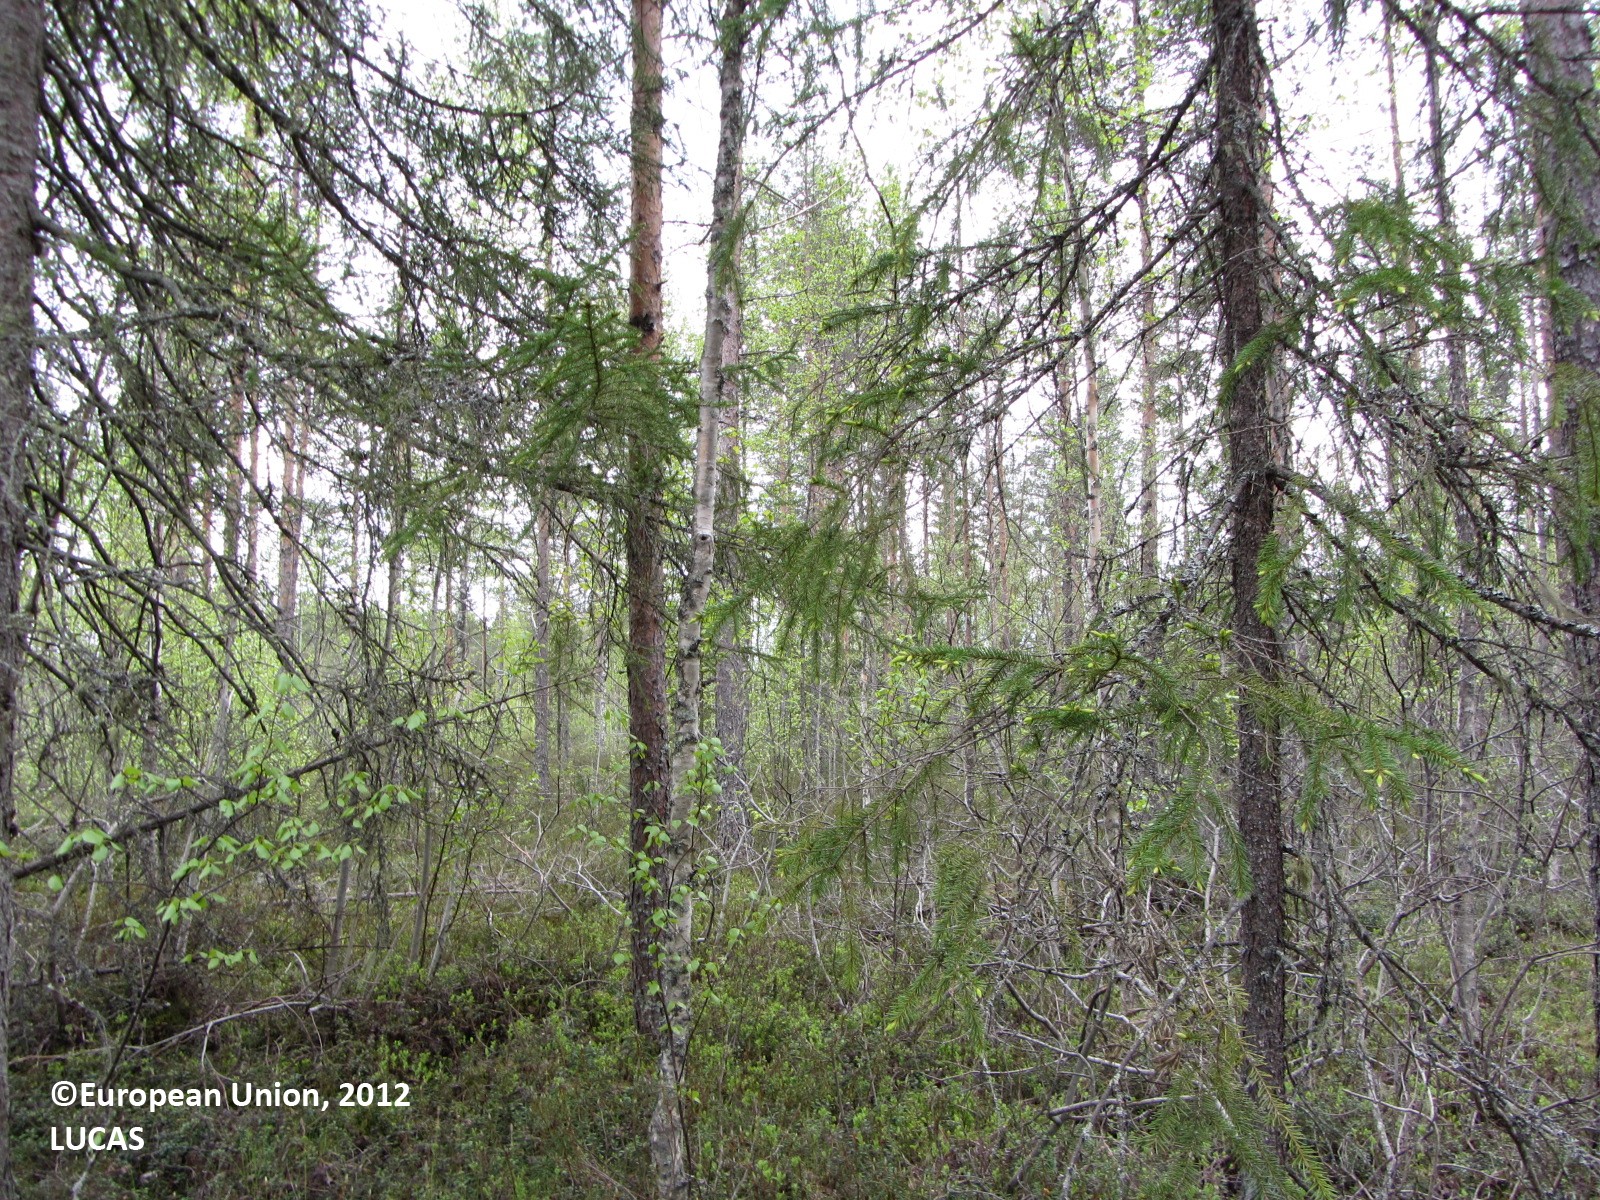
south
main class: Woodland
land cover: Pine dominated mixed woodland
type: boreal forest
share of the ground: > 75 %
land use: Forestry
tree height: > 5 m
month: June
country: FI
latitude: 63.8378
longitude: 24.6962
